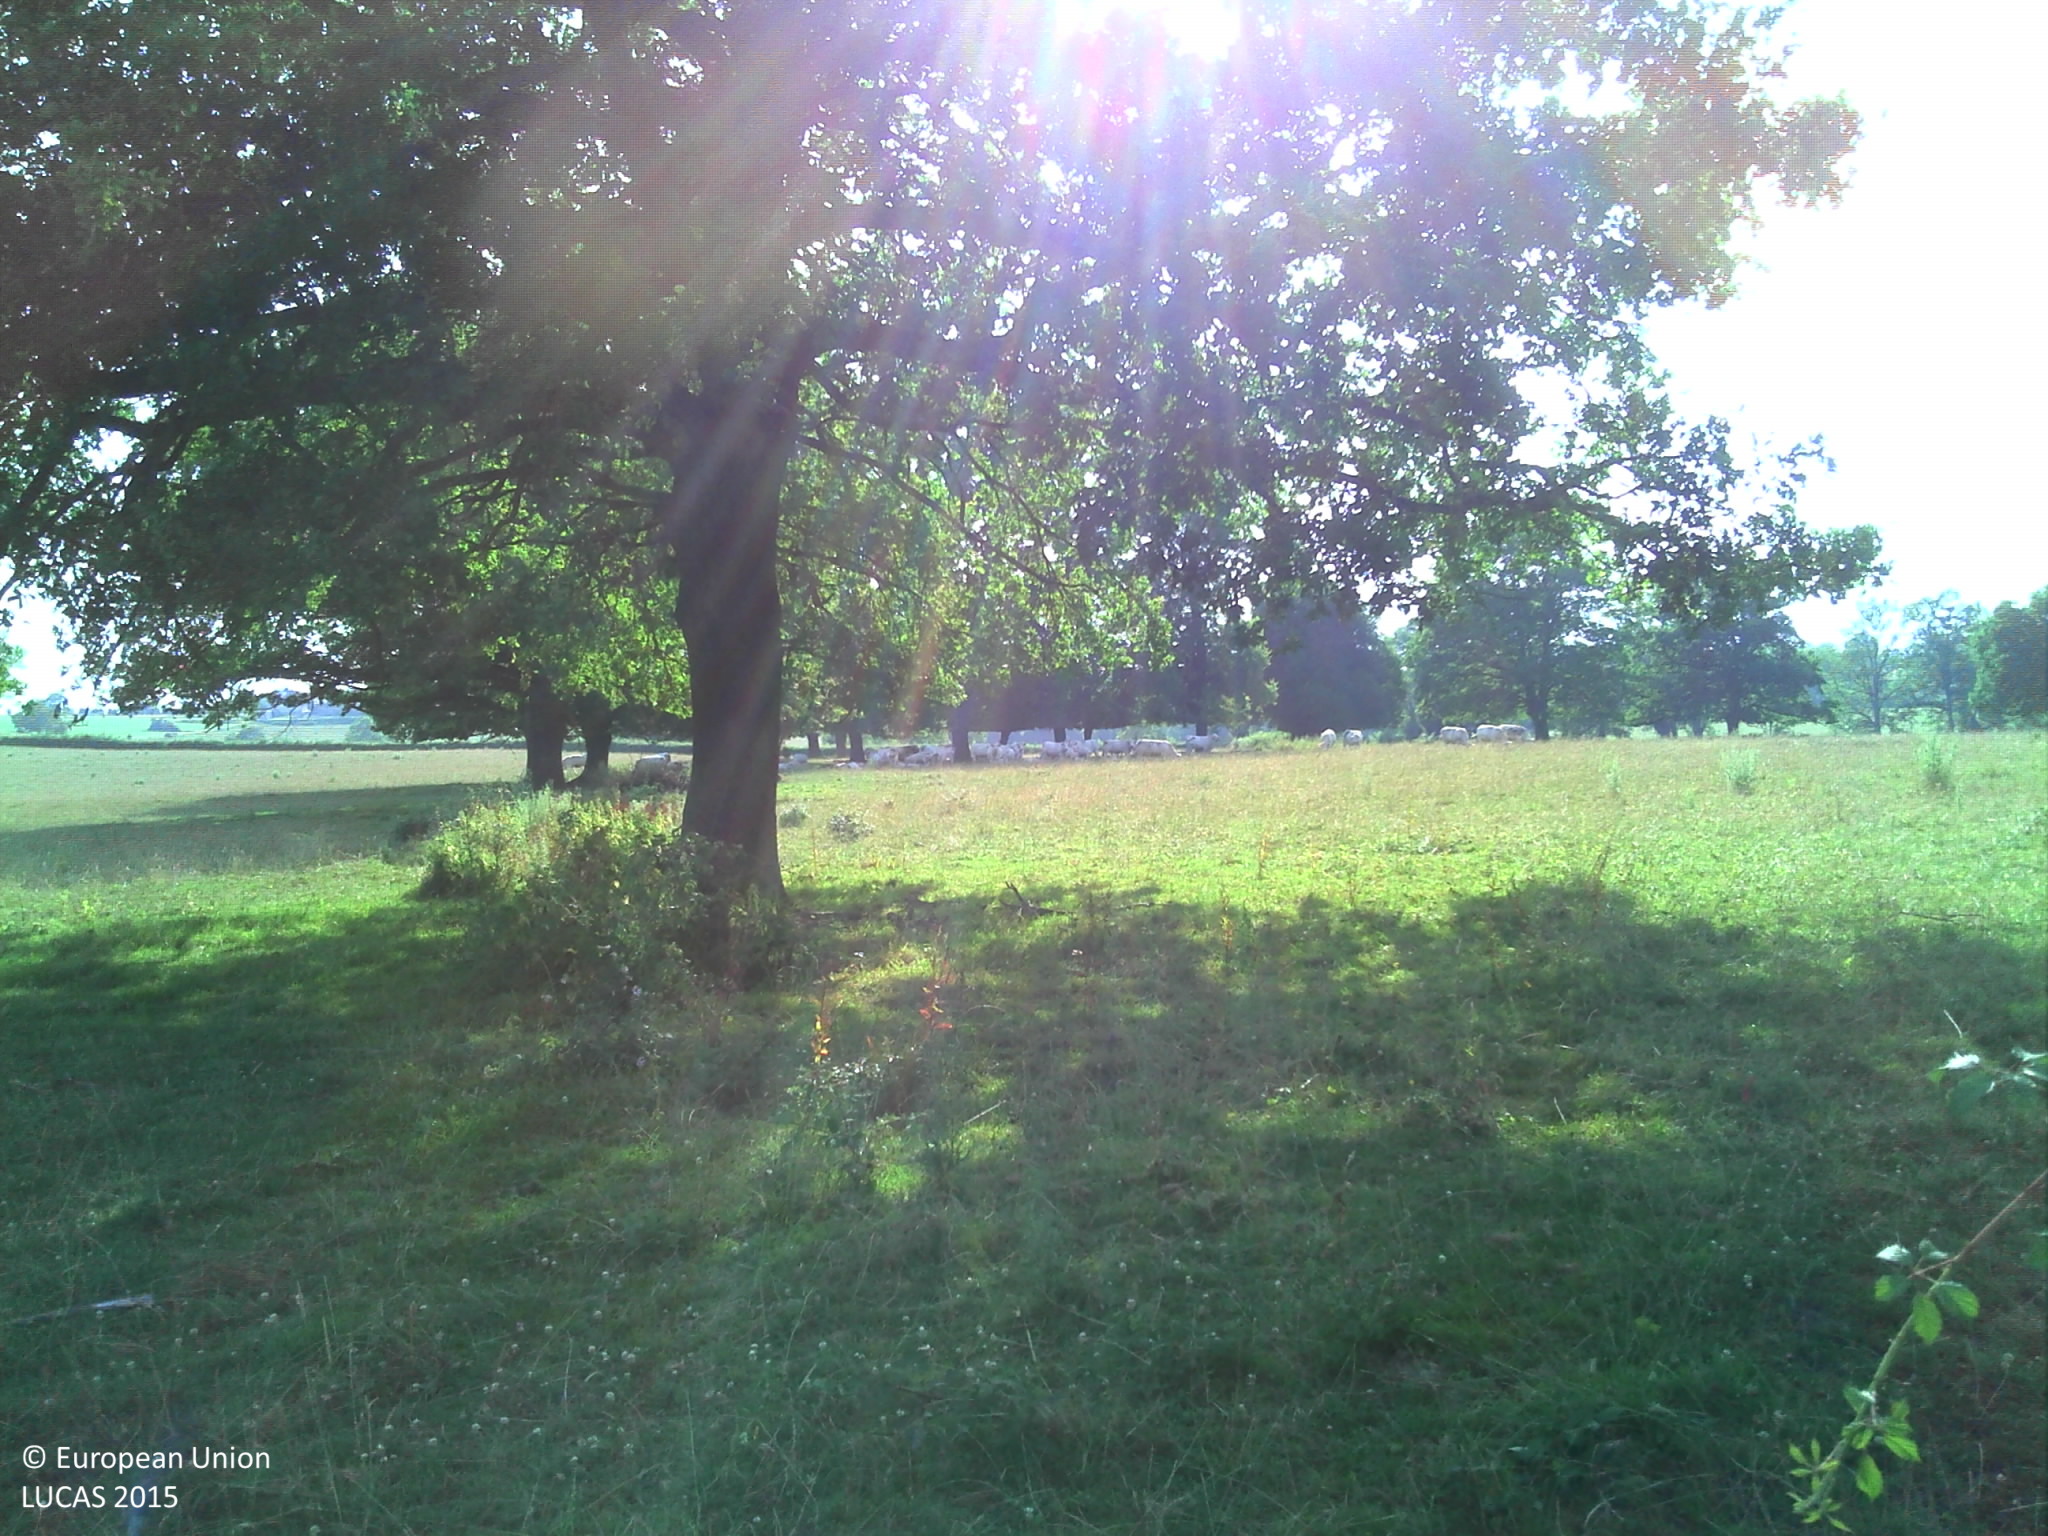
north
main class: Grassland
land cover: Grassland without tree/shrub cover
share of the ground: > 75 %
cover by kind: herbaceous plants 100 %
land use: Agriculture (excluding fallow land and kitchen gardens)
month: July
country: FR
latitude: 47.3517
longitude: 3.6029
